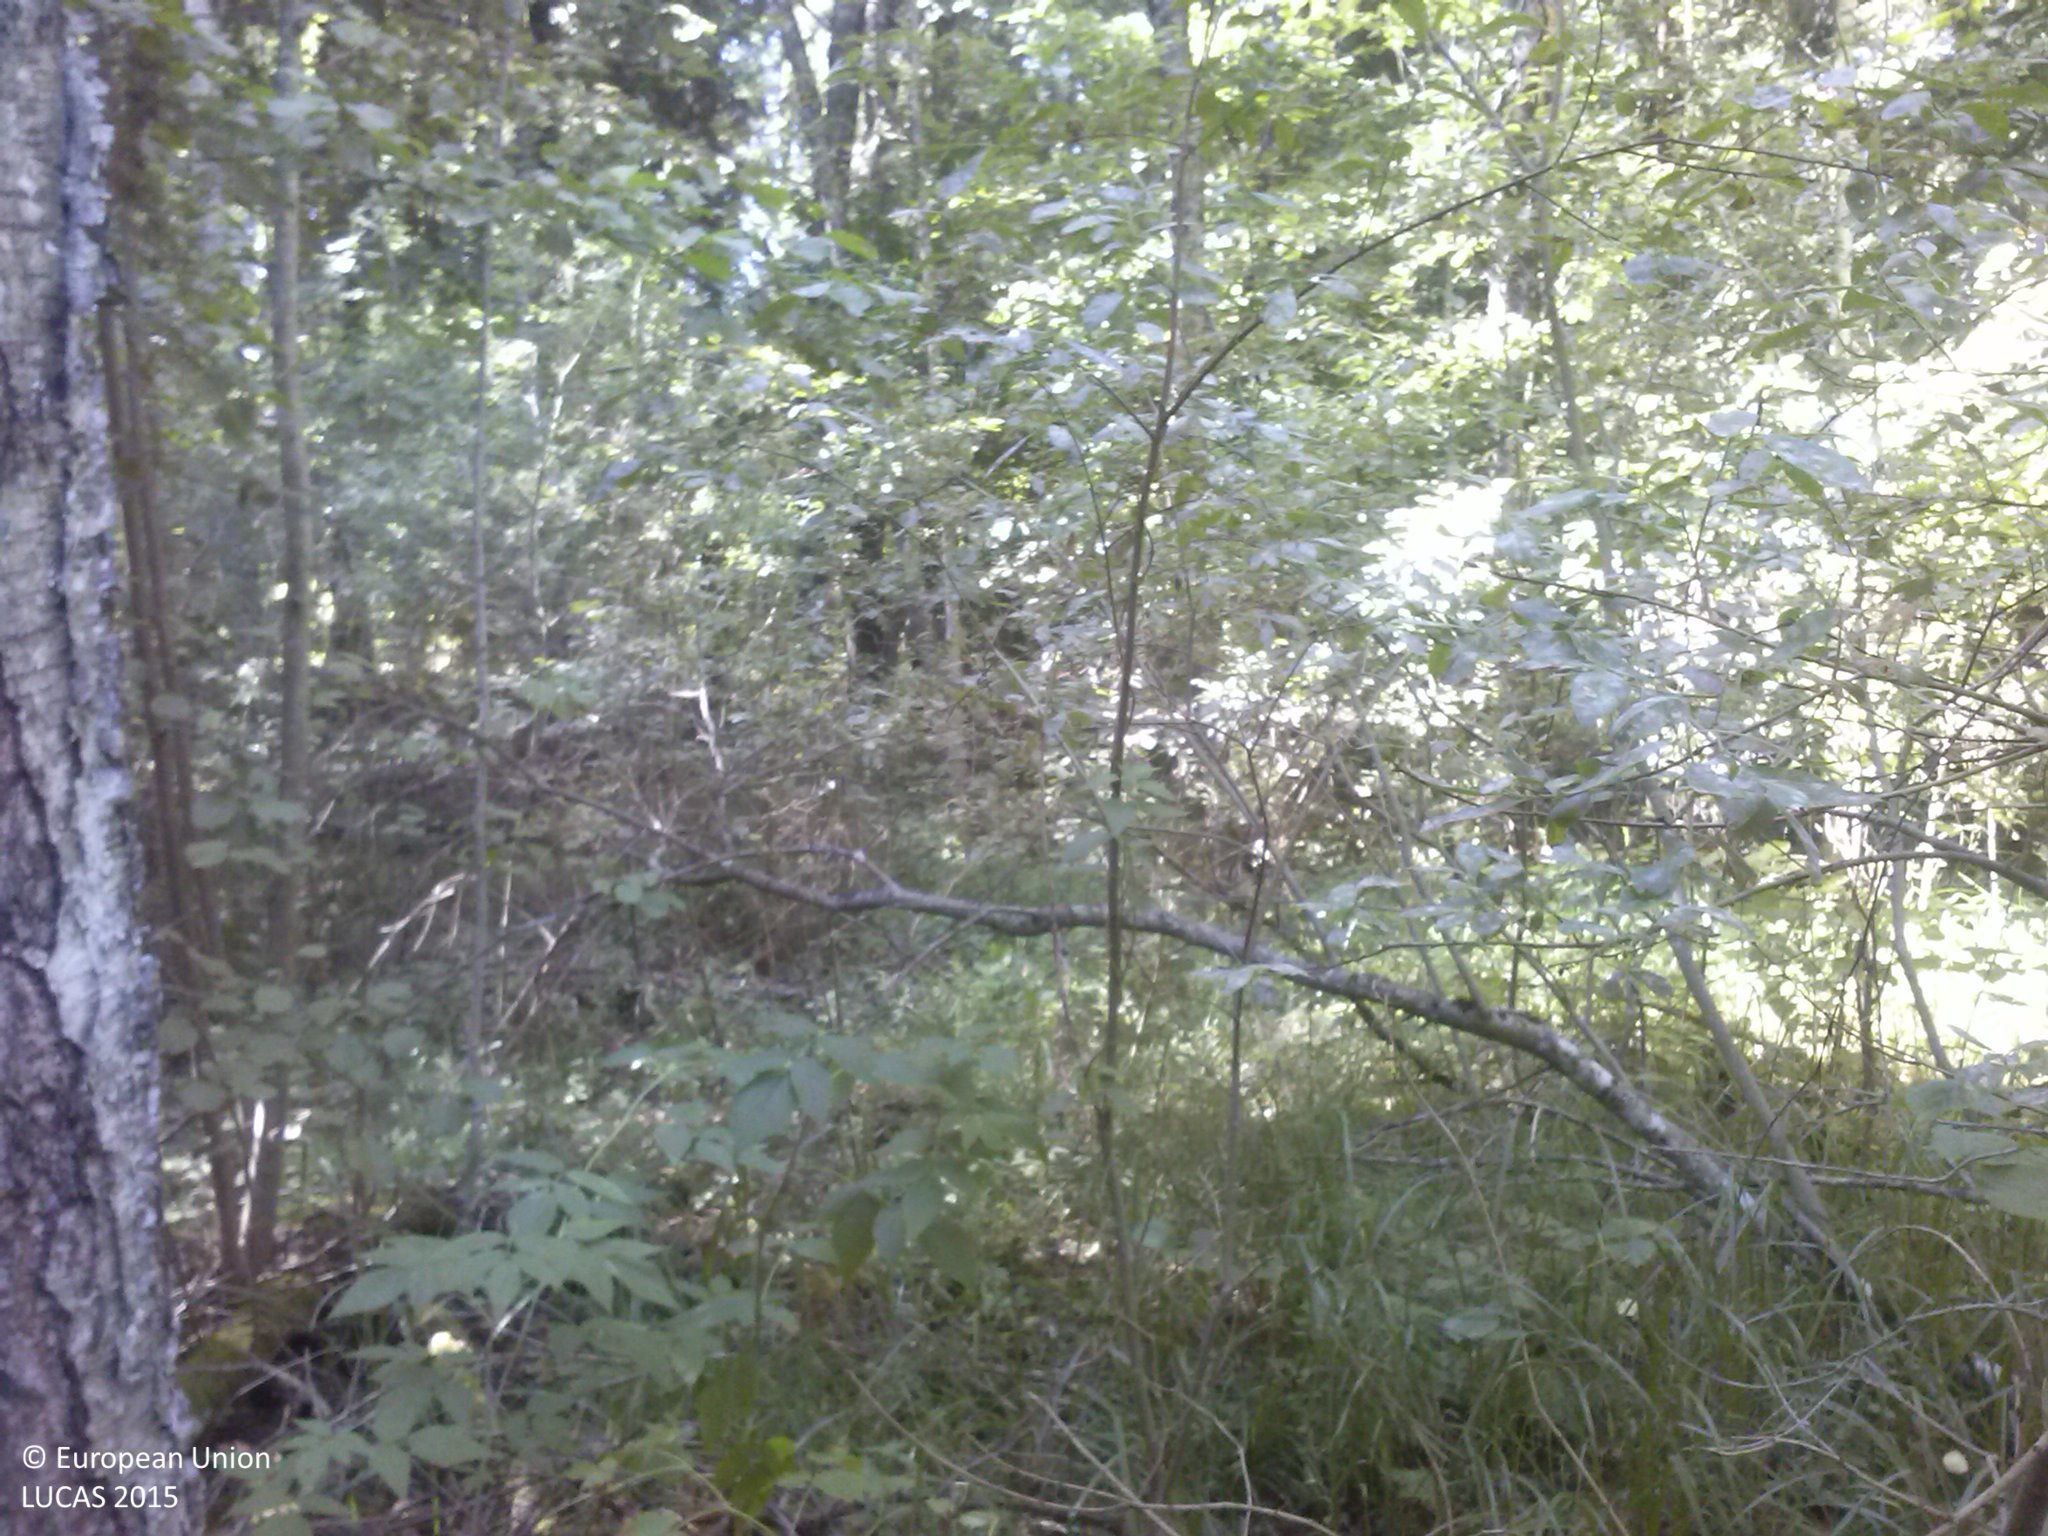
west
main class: Woodland
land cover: Broadleaved woodland
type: non-riverine alder, birch or aspen forest
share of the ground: > 75 %
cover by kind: broadleaved forest trees 75 %, herbaceous plants 25 %
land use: Forestry
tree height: > 5 m
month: August
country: LV
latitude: 56.2430
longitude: 26.8277
